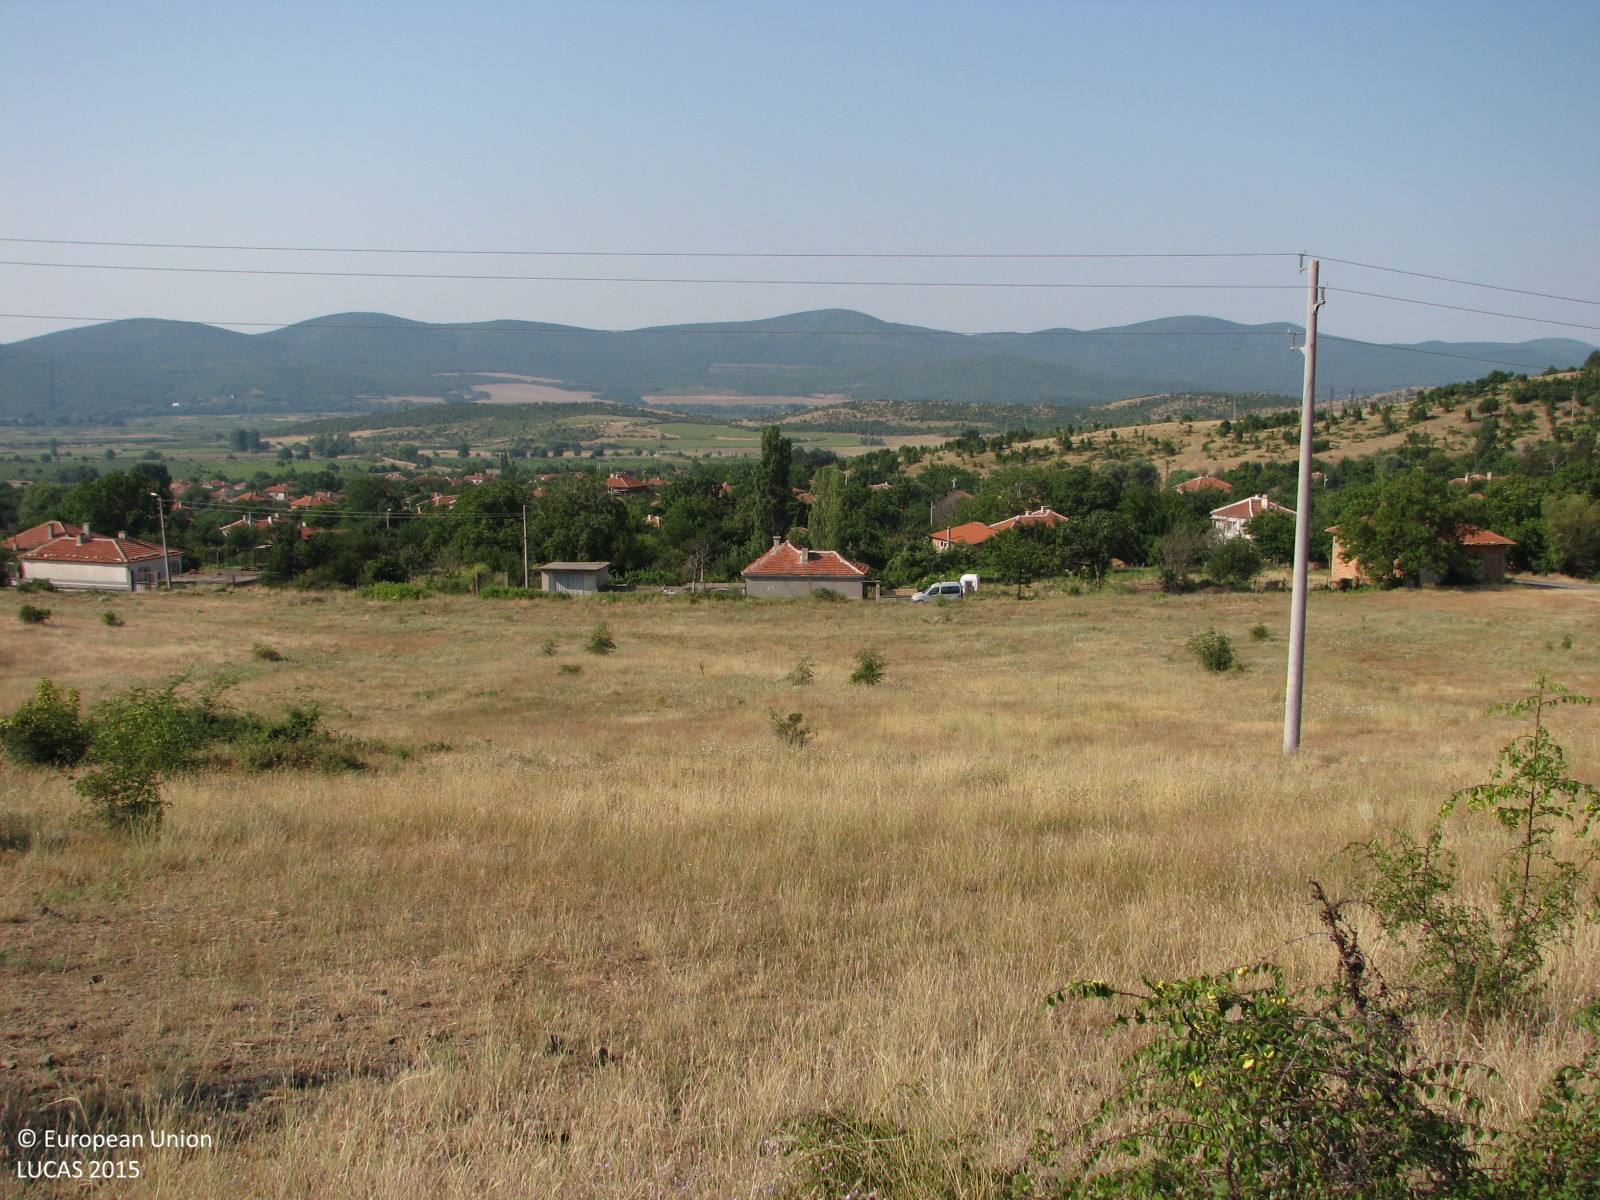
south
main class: Grassland
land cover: Grassland with sparse tree/shrub cover
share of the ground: > 75 %
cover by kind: herbaceous plants 90 %, broadleaved forest trees 5 %, shrubs 5 %
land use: Agriculture (excluding fallow land and kitchen gardens)
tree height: < 5 m
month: July
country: BG
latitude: 42.6526
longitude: 26.1512
